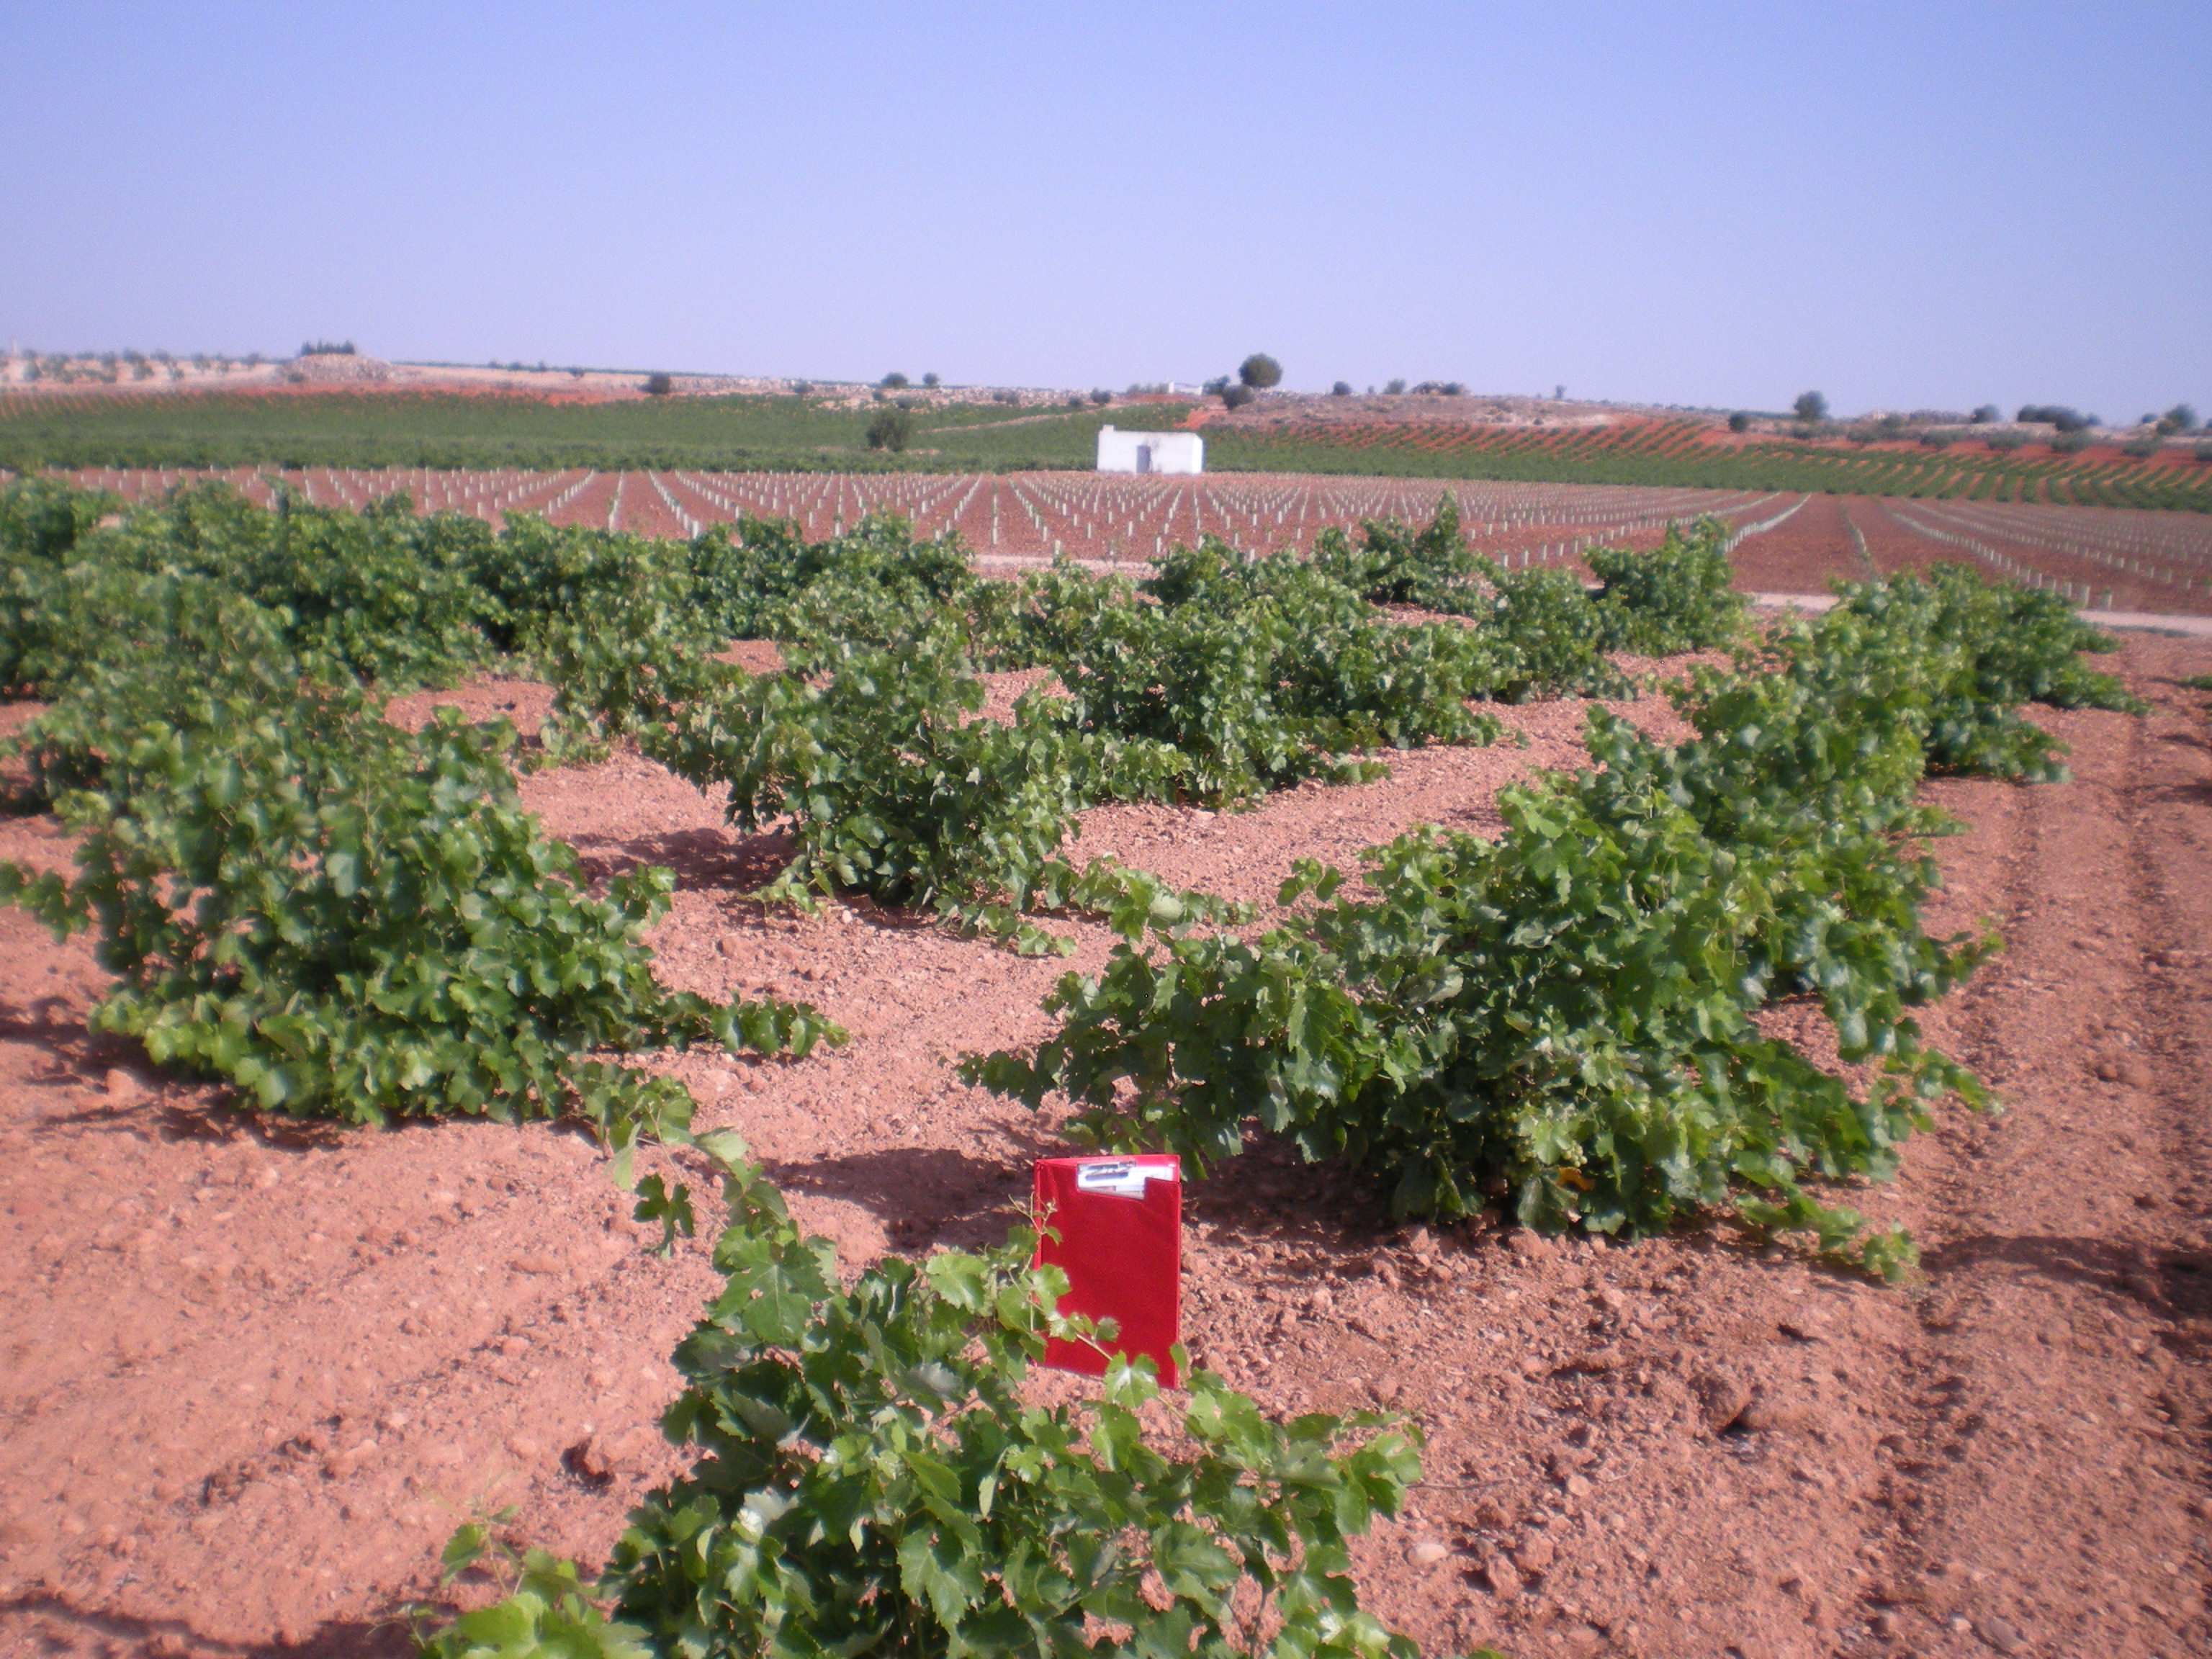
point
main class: Cropland
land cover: Vineyards
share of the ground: 10 - 25 %
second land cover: Other bare soil
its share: > 75 %
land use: Agriculture (excluding fallow land and kitchen gardens)
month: July
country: ES
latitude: 39.5063
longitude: -3.1490
